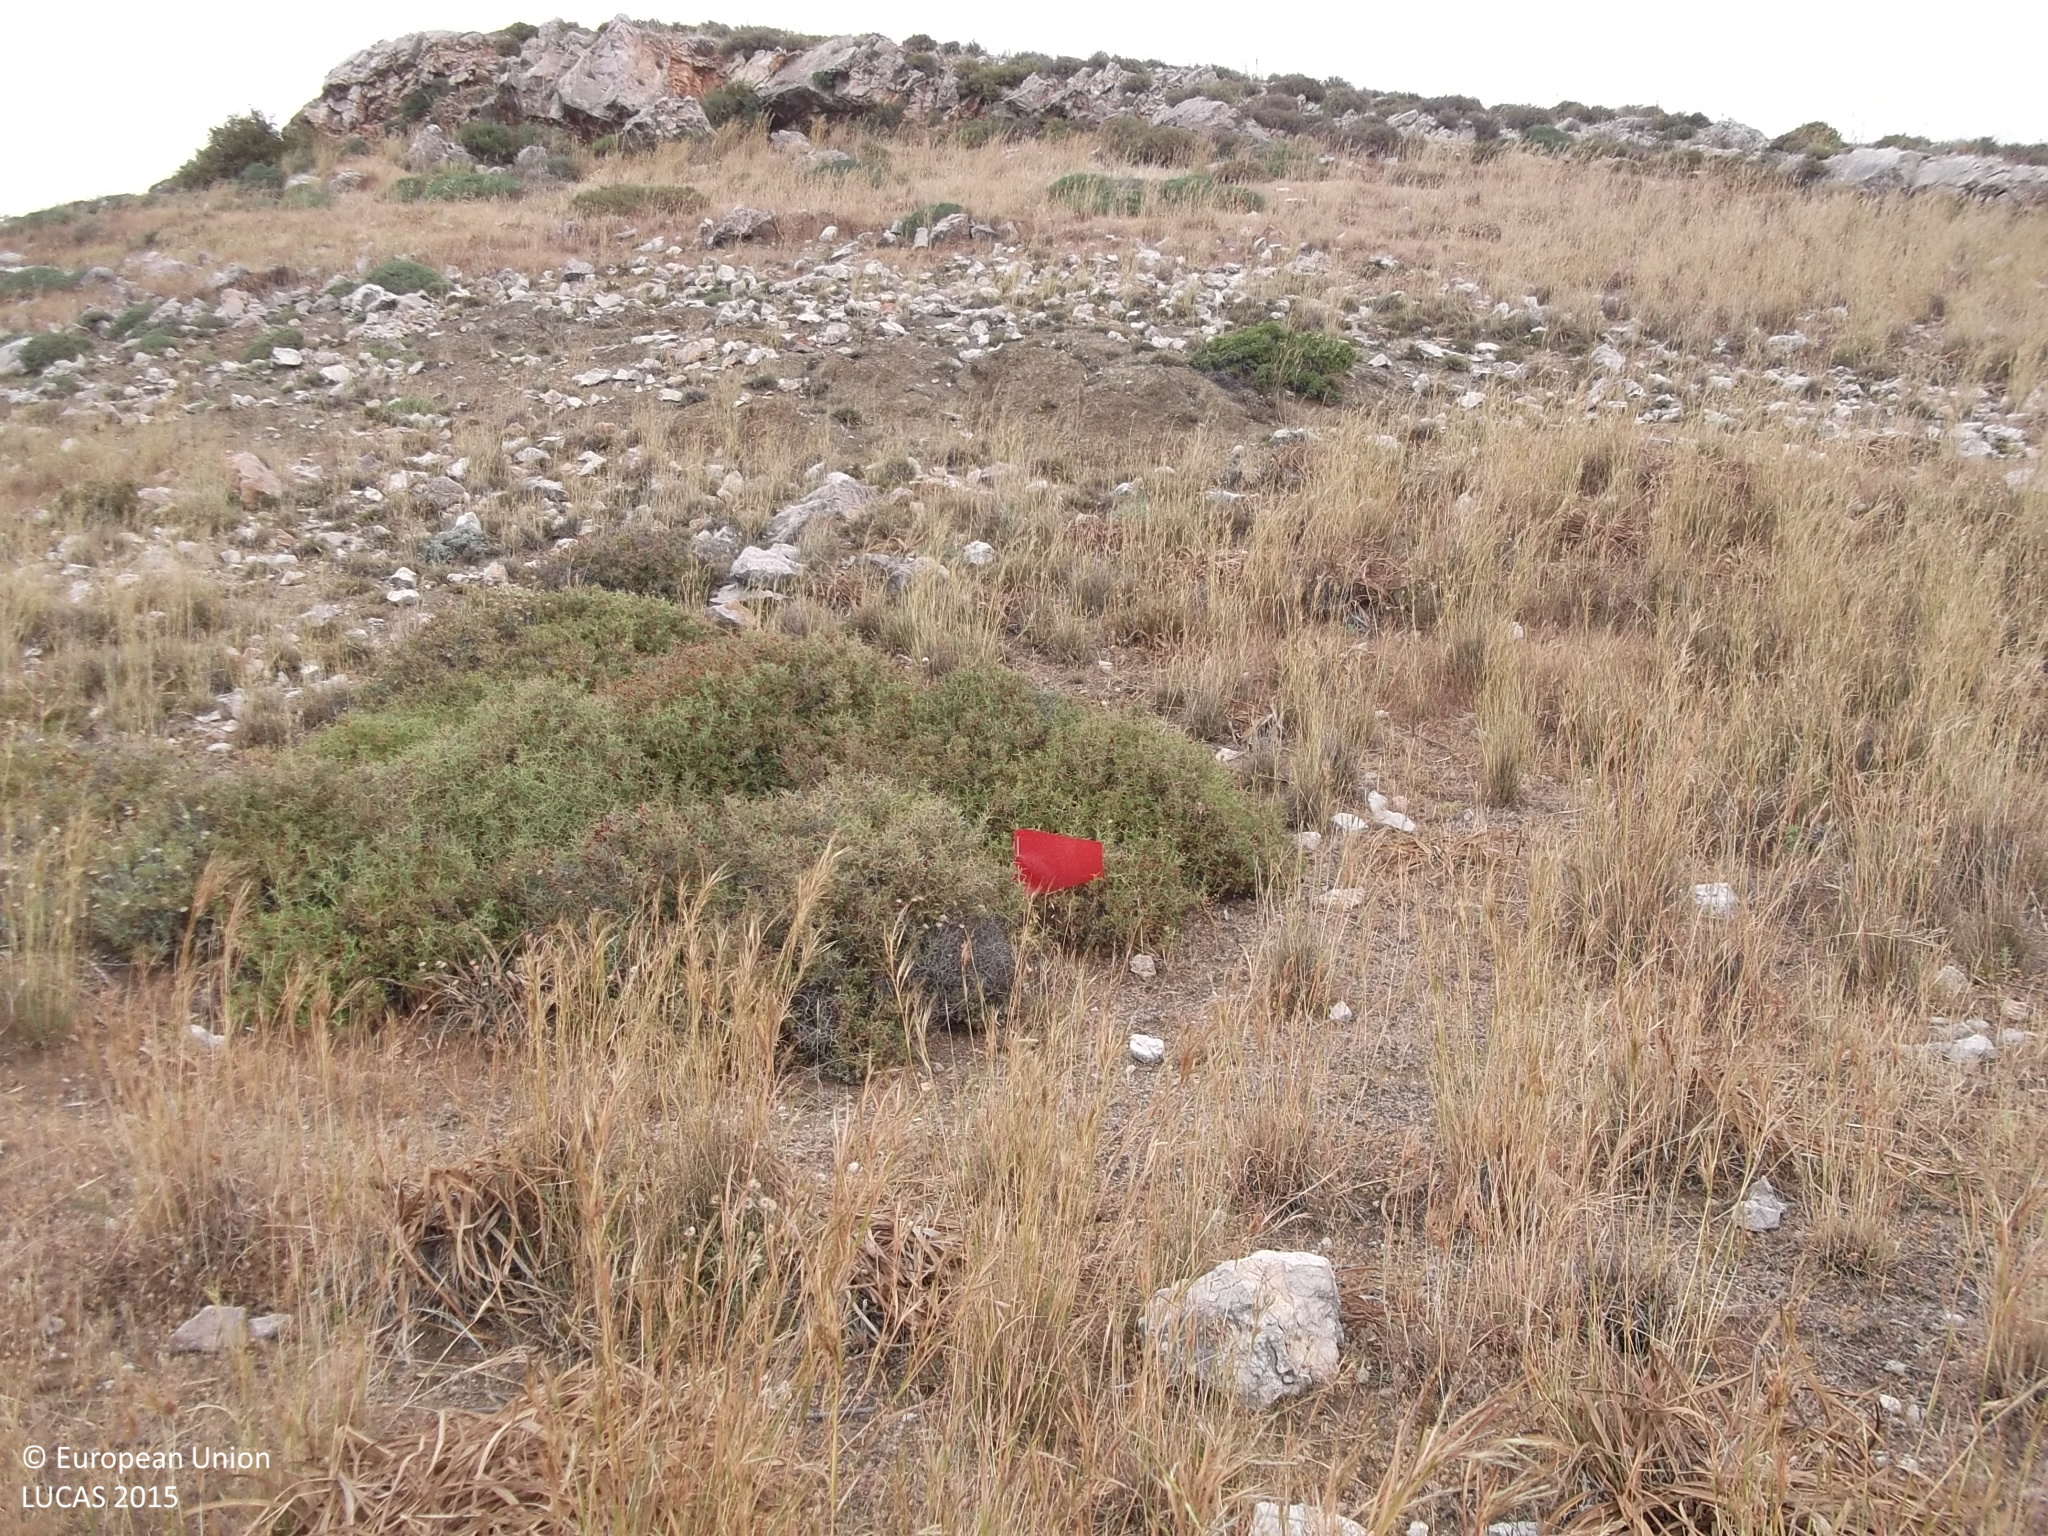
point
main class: Shrubland
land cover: Shrubland without tree cover
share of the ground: 25 - 50 %
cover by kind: herbaceous plants 50 %, shrubs 30 %, unconsolidated bare surface 20 %
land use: Semi-natural and natural areas not in use
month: May
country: CY
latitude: 34.7620
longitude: 32.5341
